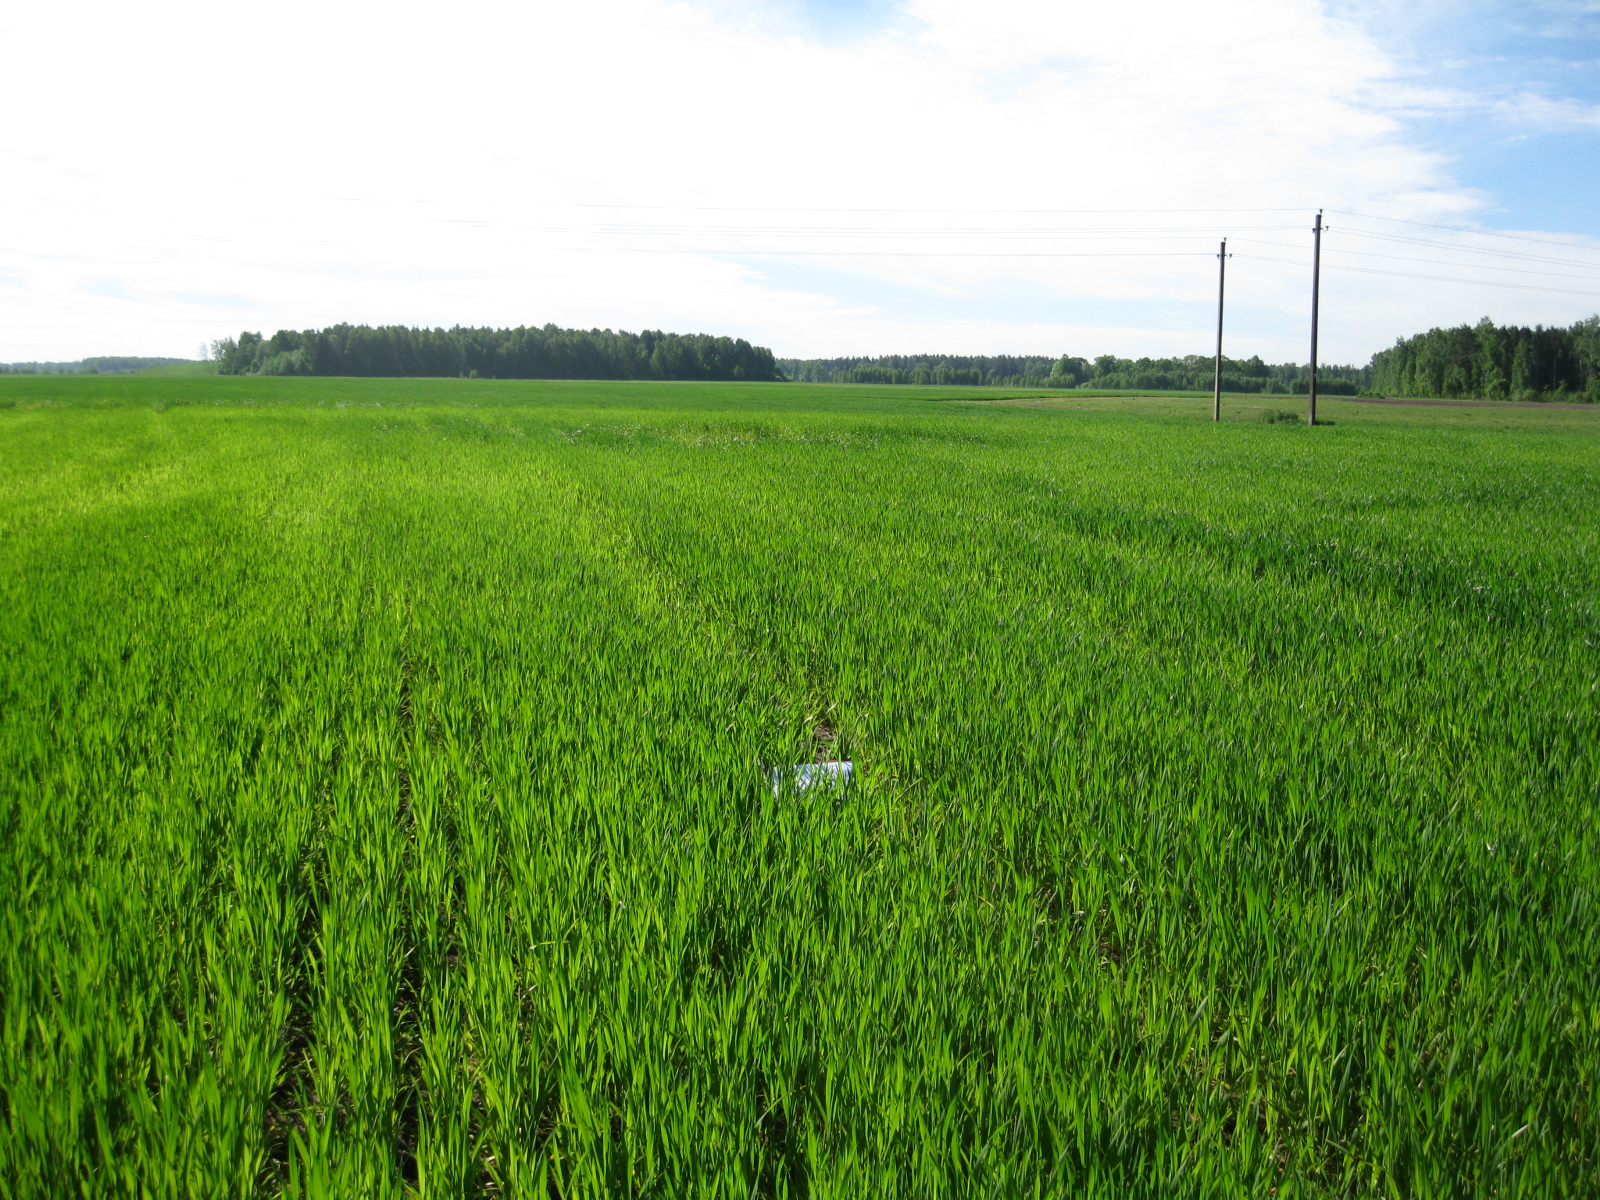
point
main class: Cropland
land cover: Common wheat
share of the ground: > 75 %
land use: Agriculture (excluding fallow land and kitchen gardens)
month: May
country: LT
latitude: 55.8359
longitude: 24.3215
